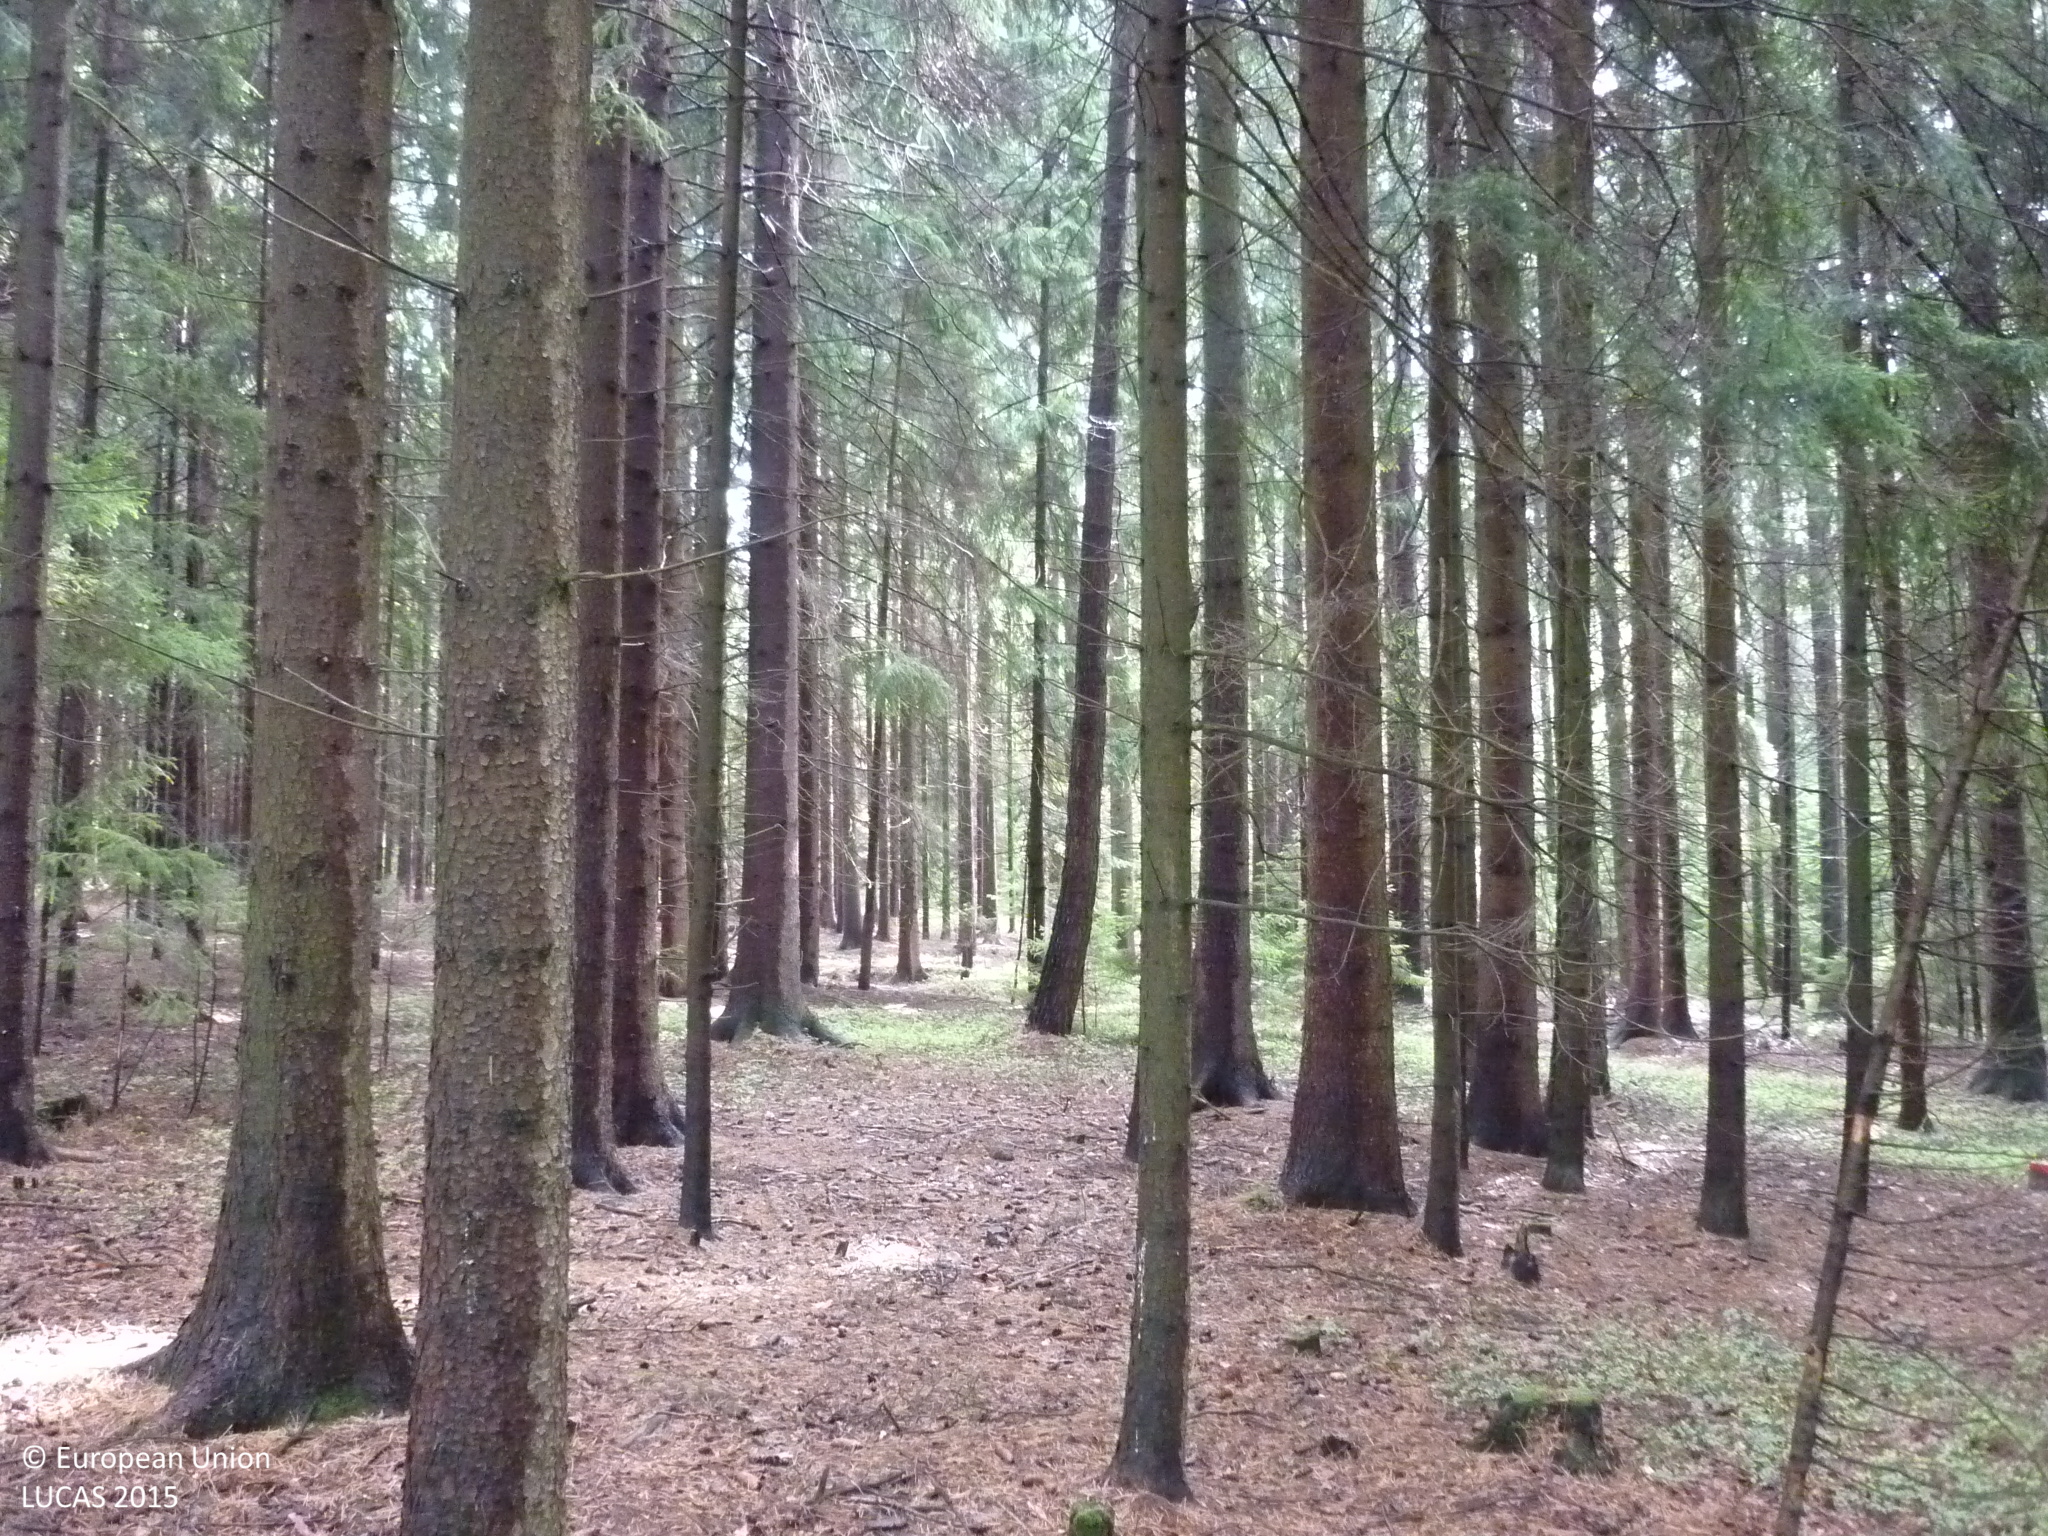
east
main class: Woodland
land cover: Spruce dominated coniferous woodland
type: hemiboreal forest and nemoral coniferous forest and mixed broadleaved-coniferous forest
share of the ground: > 75 %
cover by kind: coniferous forest trees 100 %
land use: Forestry
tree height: > 5 m
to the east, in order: Spruce dominated coniferous woodland; Tracks; Spruce dominated coniferous woodland; Tracks; Spruce dominated coniferous woodland; Tracks; Spruce dominated coniferous woodland; Tracks; Spruce dominated coniferous woodland; Tracks; Spruce dominated coniferous woodland
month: September
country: AT
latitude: 48.9543
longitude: 15.0687
